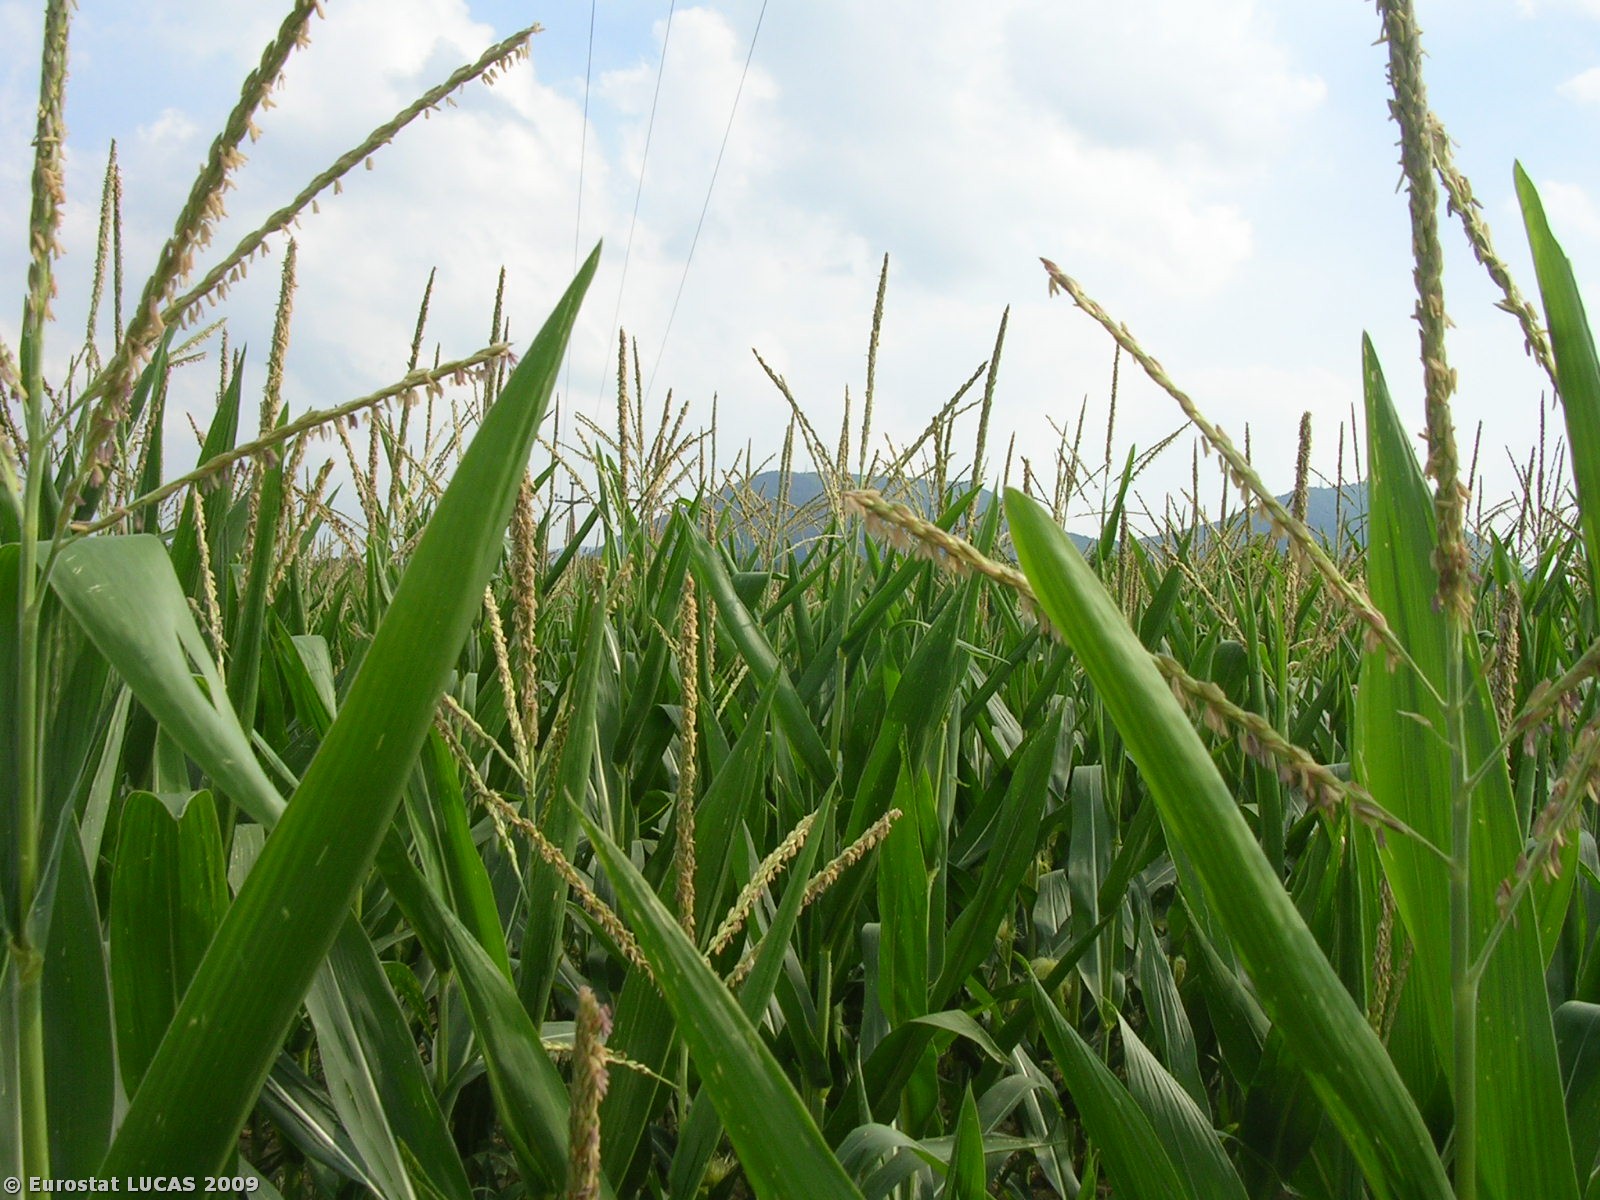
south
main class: Cropland
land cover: Soya
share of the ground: > 75 %
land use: Agriculture (excluding fallow land and kitchen gardens)
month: July
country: IT
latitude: 45.4011
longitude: 11.6708
